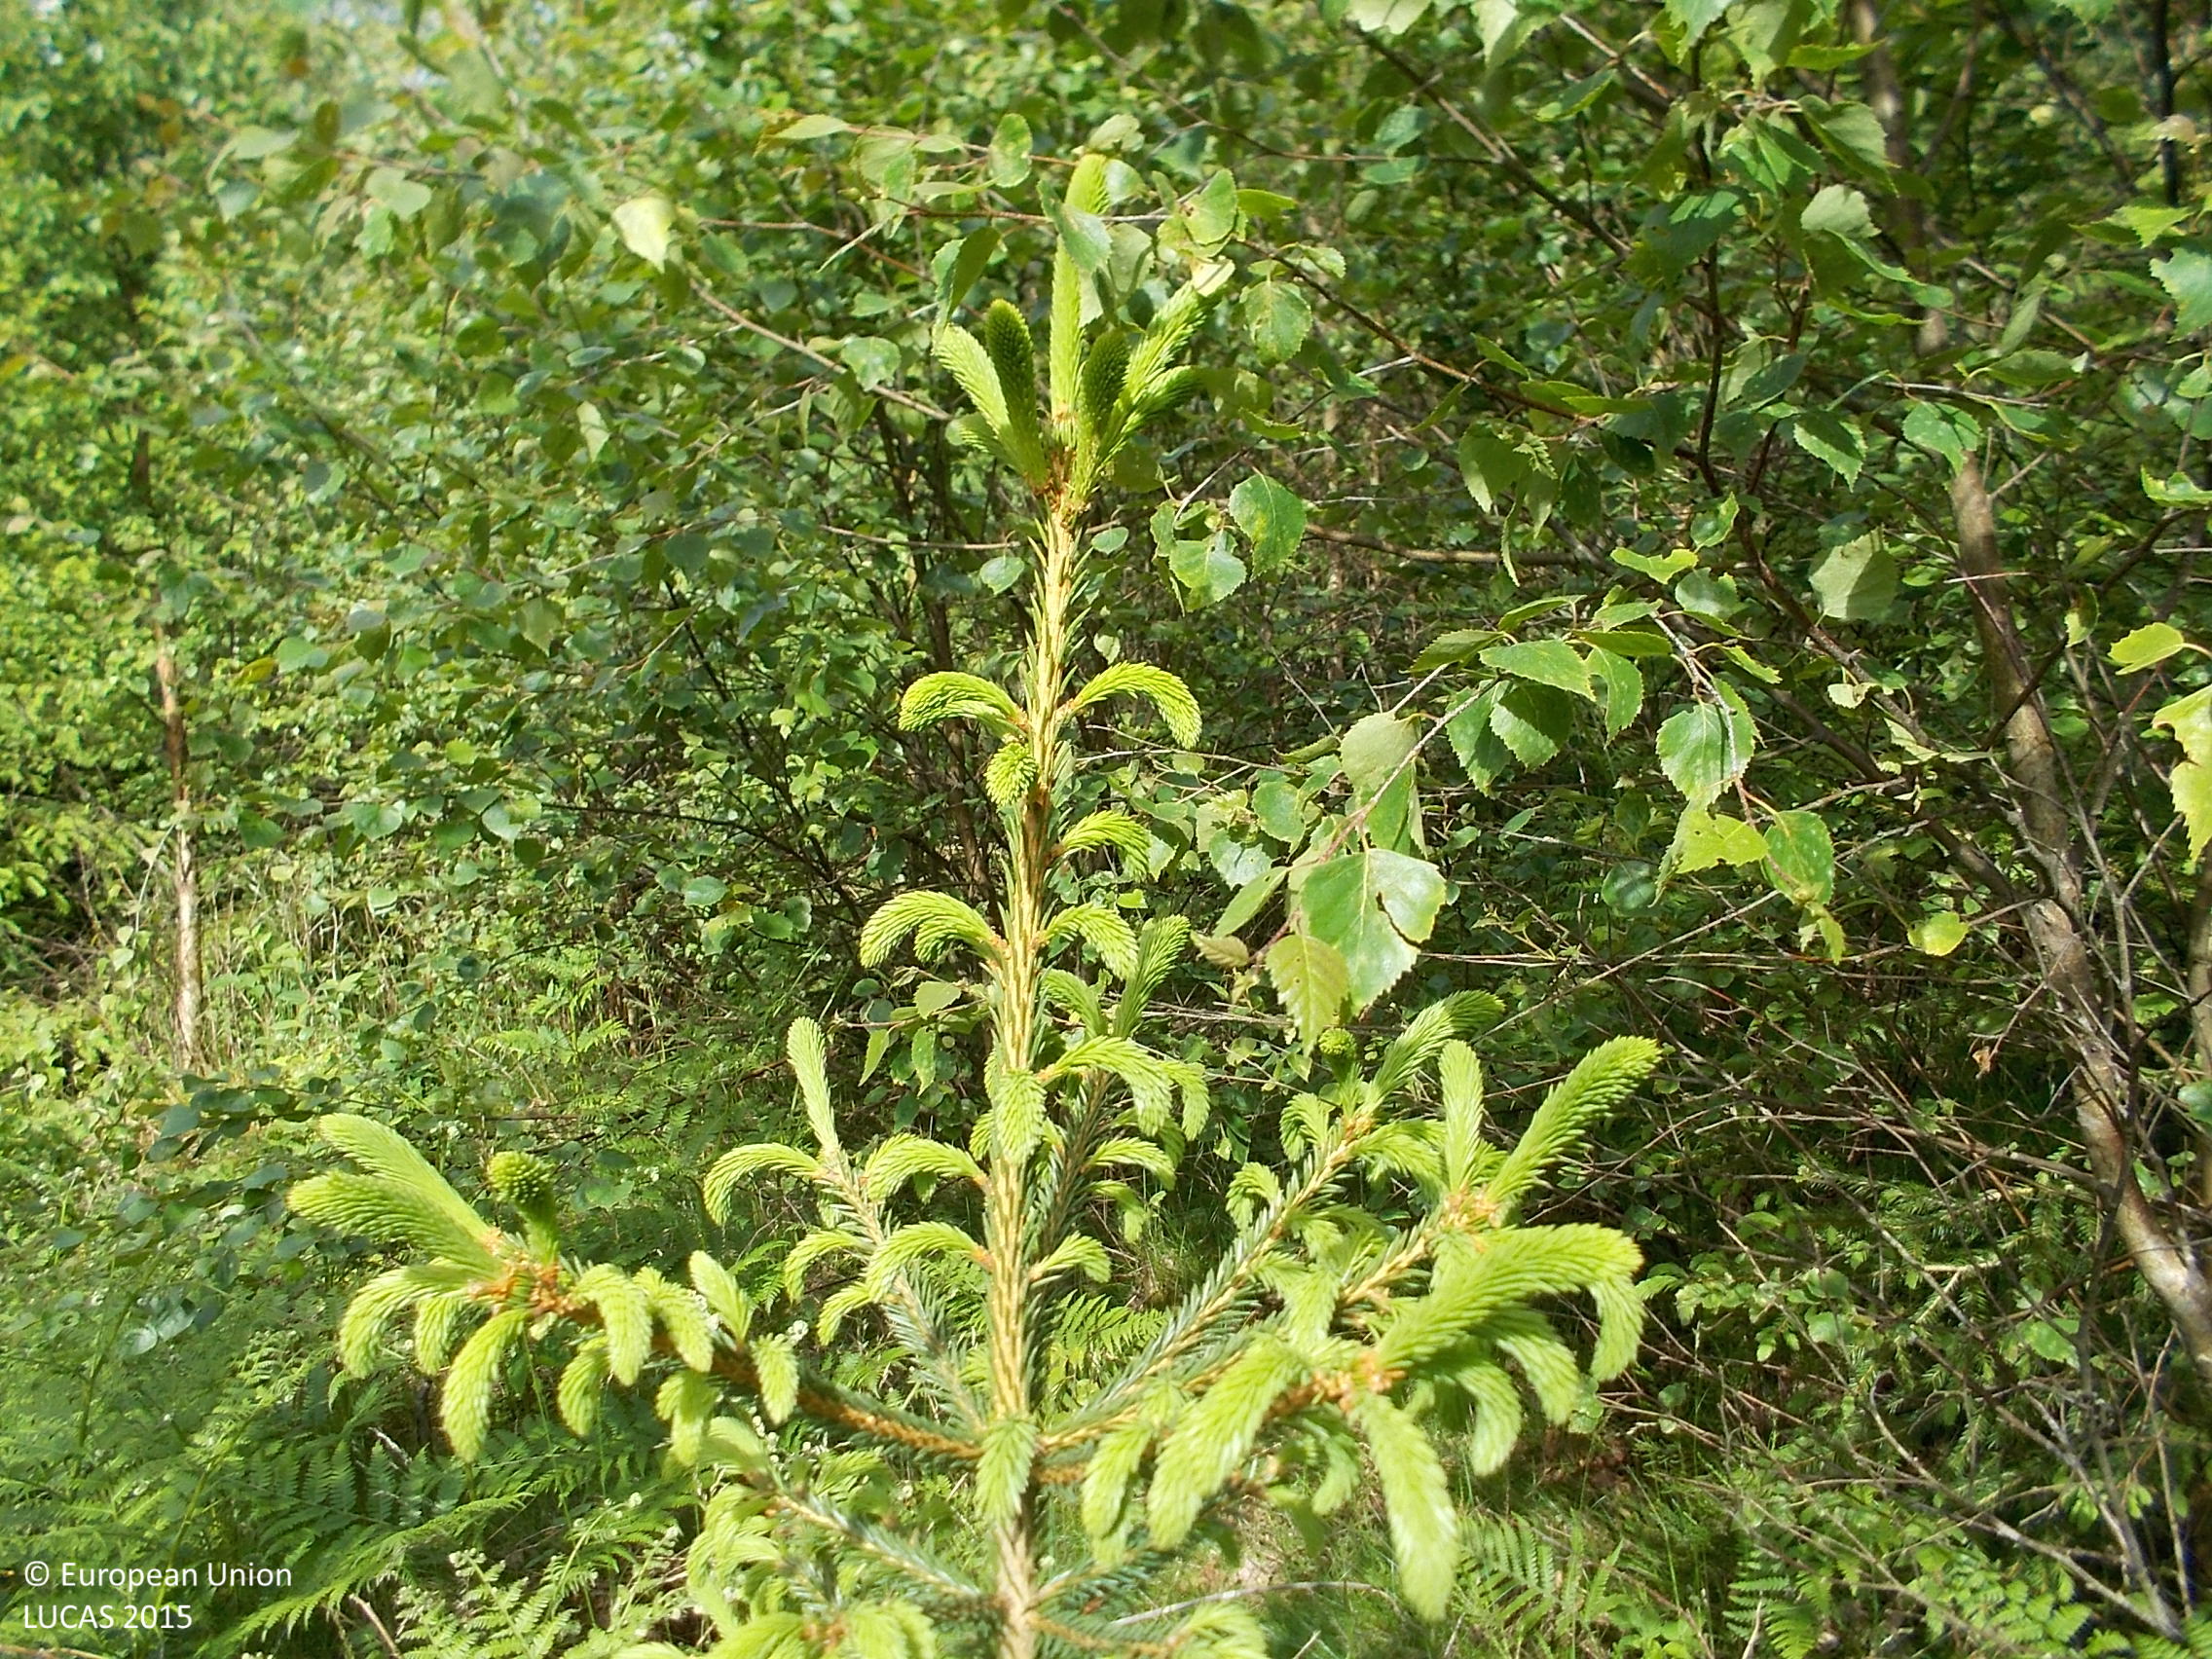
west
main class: Woodland
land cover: Broadleaved woodland
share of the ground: > 75 %
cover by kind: broadleaved forest trees 70 %, herbaceous plants 10 %, lichens and mosses 10 %, coniferous forest trees 5 %, shrubs 5 %
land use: Forestry
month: June
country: SE
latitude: 57.1103
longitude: 12.8199
